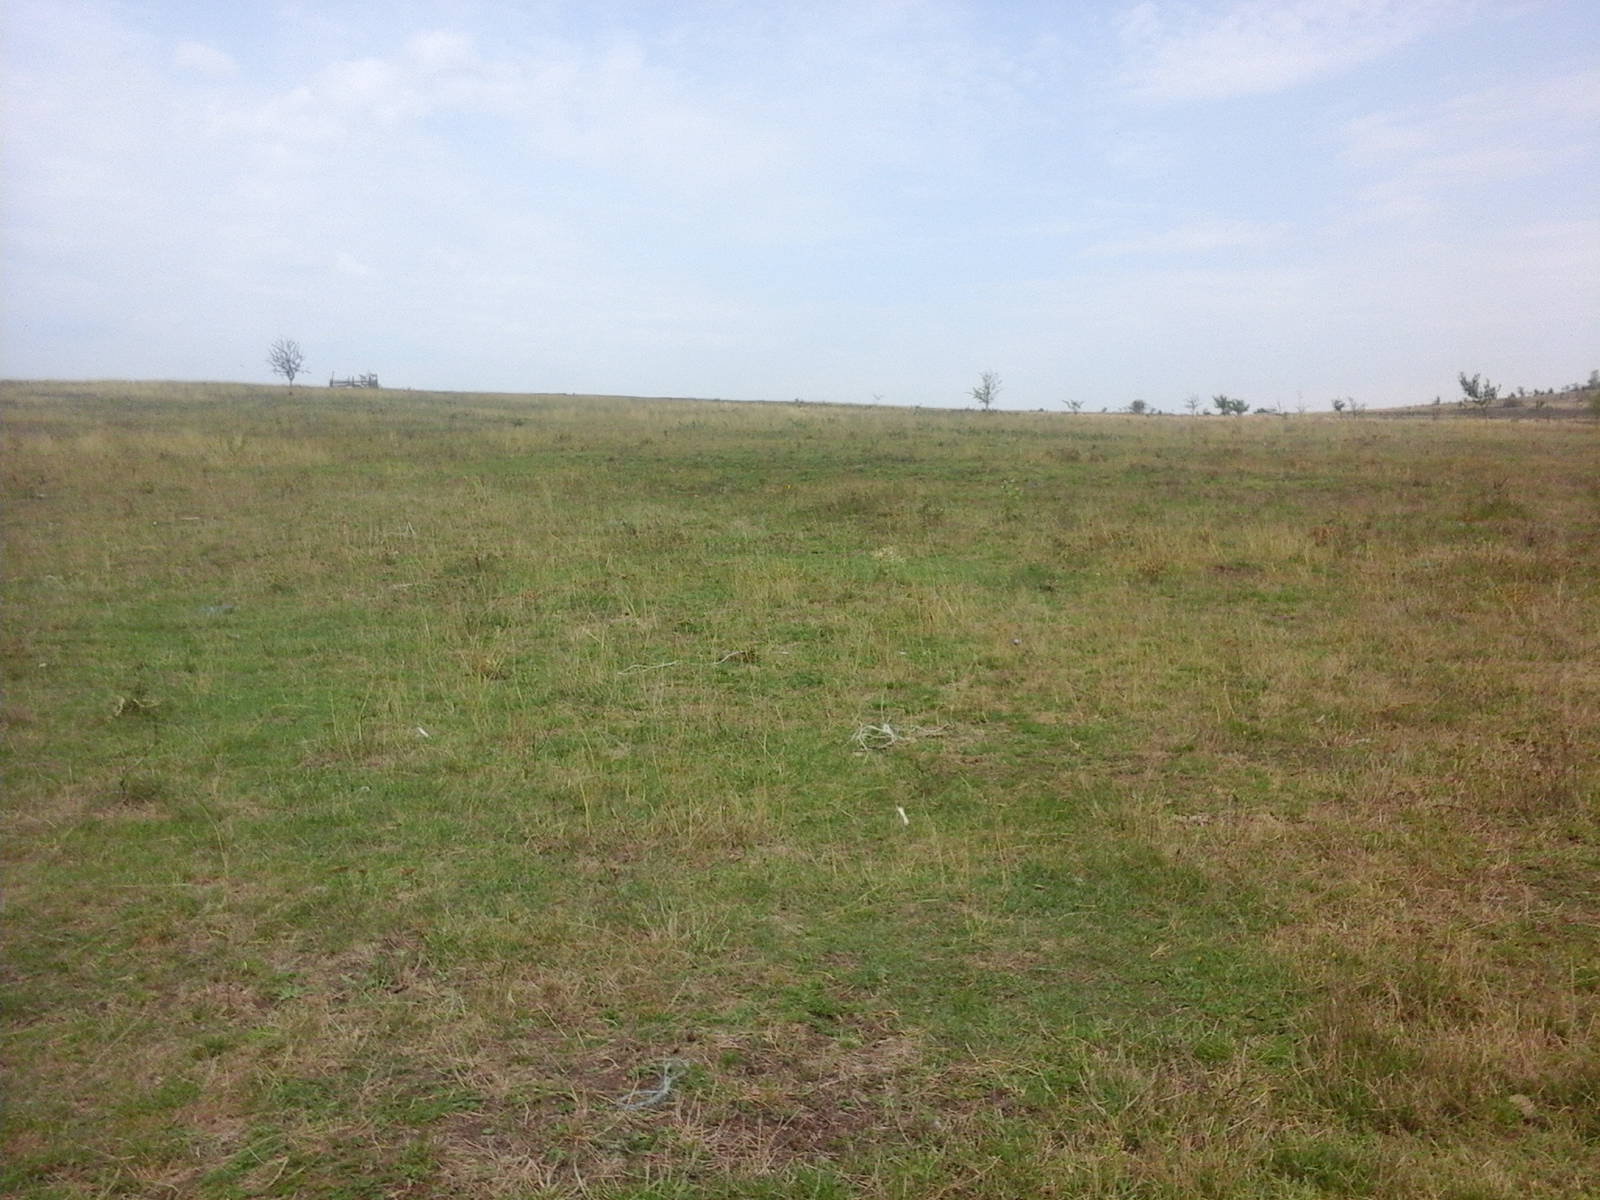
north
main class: Grassland
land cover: Spontaneously vegetated surfaces
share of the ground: > 75 %
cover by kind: herbaceous plants 100 %
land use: Agriculture (excluding fallow land and kitchen gardens)
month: September
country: RO
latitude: 45.7305
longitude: 23.0467
